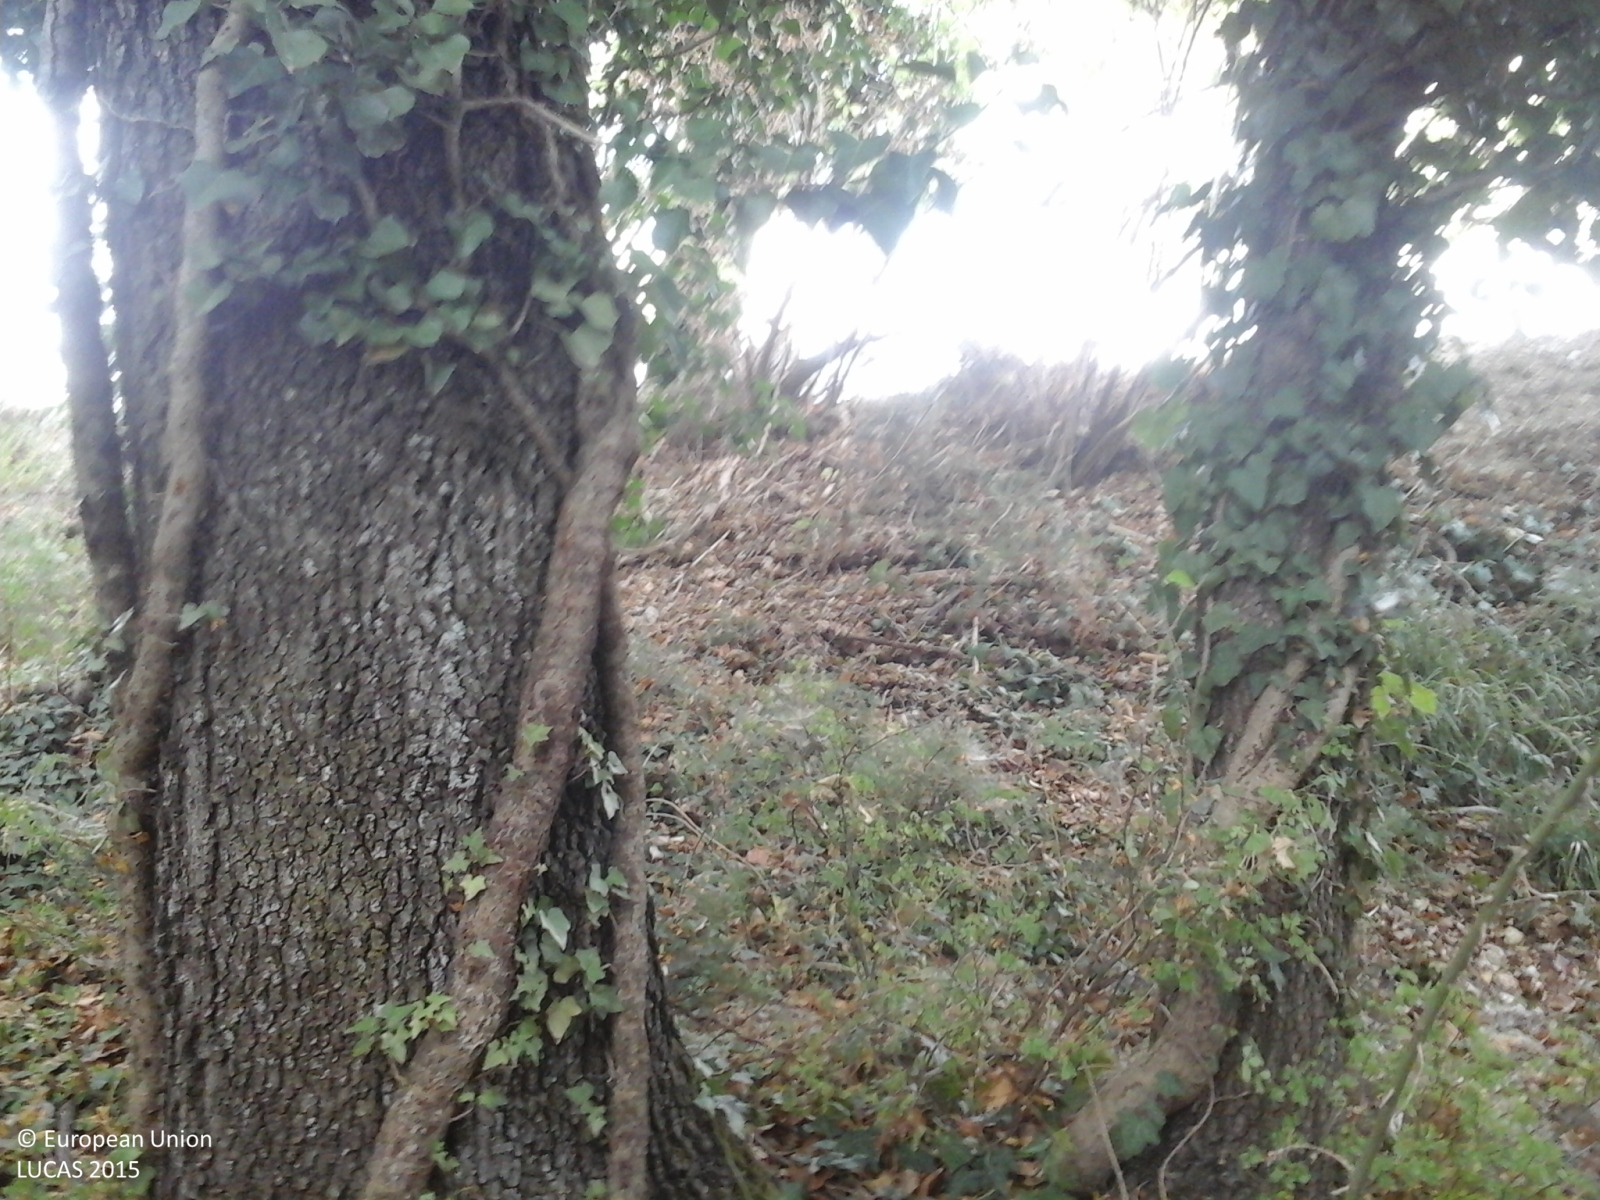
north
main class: Woodland
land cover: Broadleaved woodland
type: thermophilous deciduous forest
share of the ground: > 75 %
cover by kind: broadleaved forest trees 95 %, shrubs 5 %
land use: Forestry
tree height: > 5 m
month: July
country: IT
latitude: 43.3203
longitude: 13.3823
